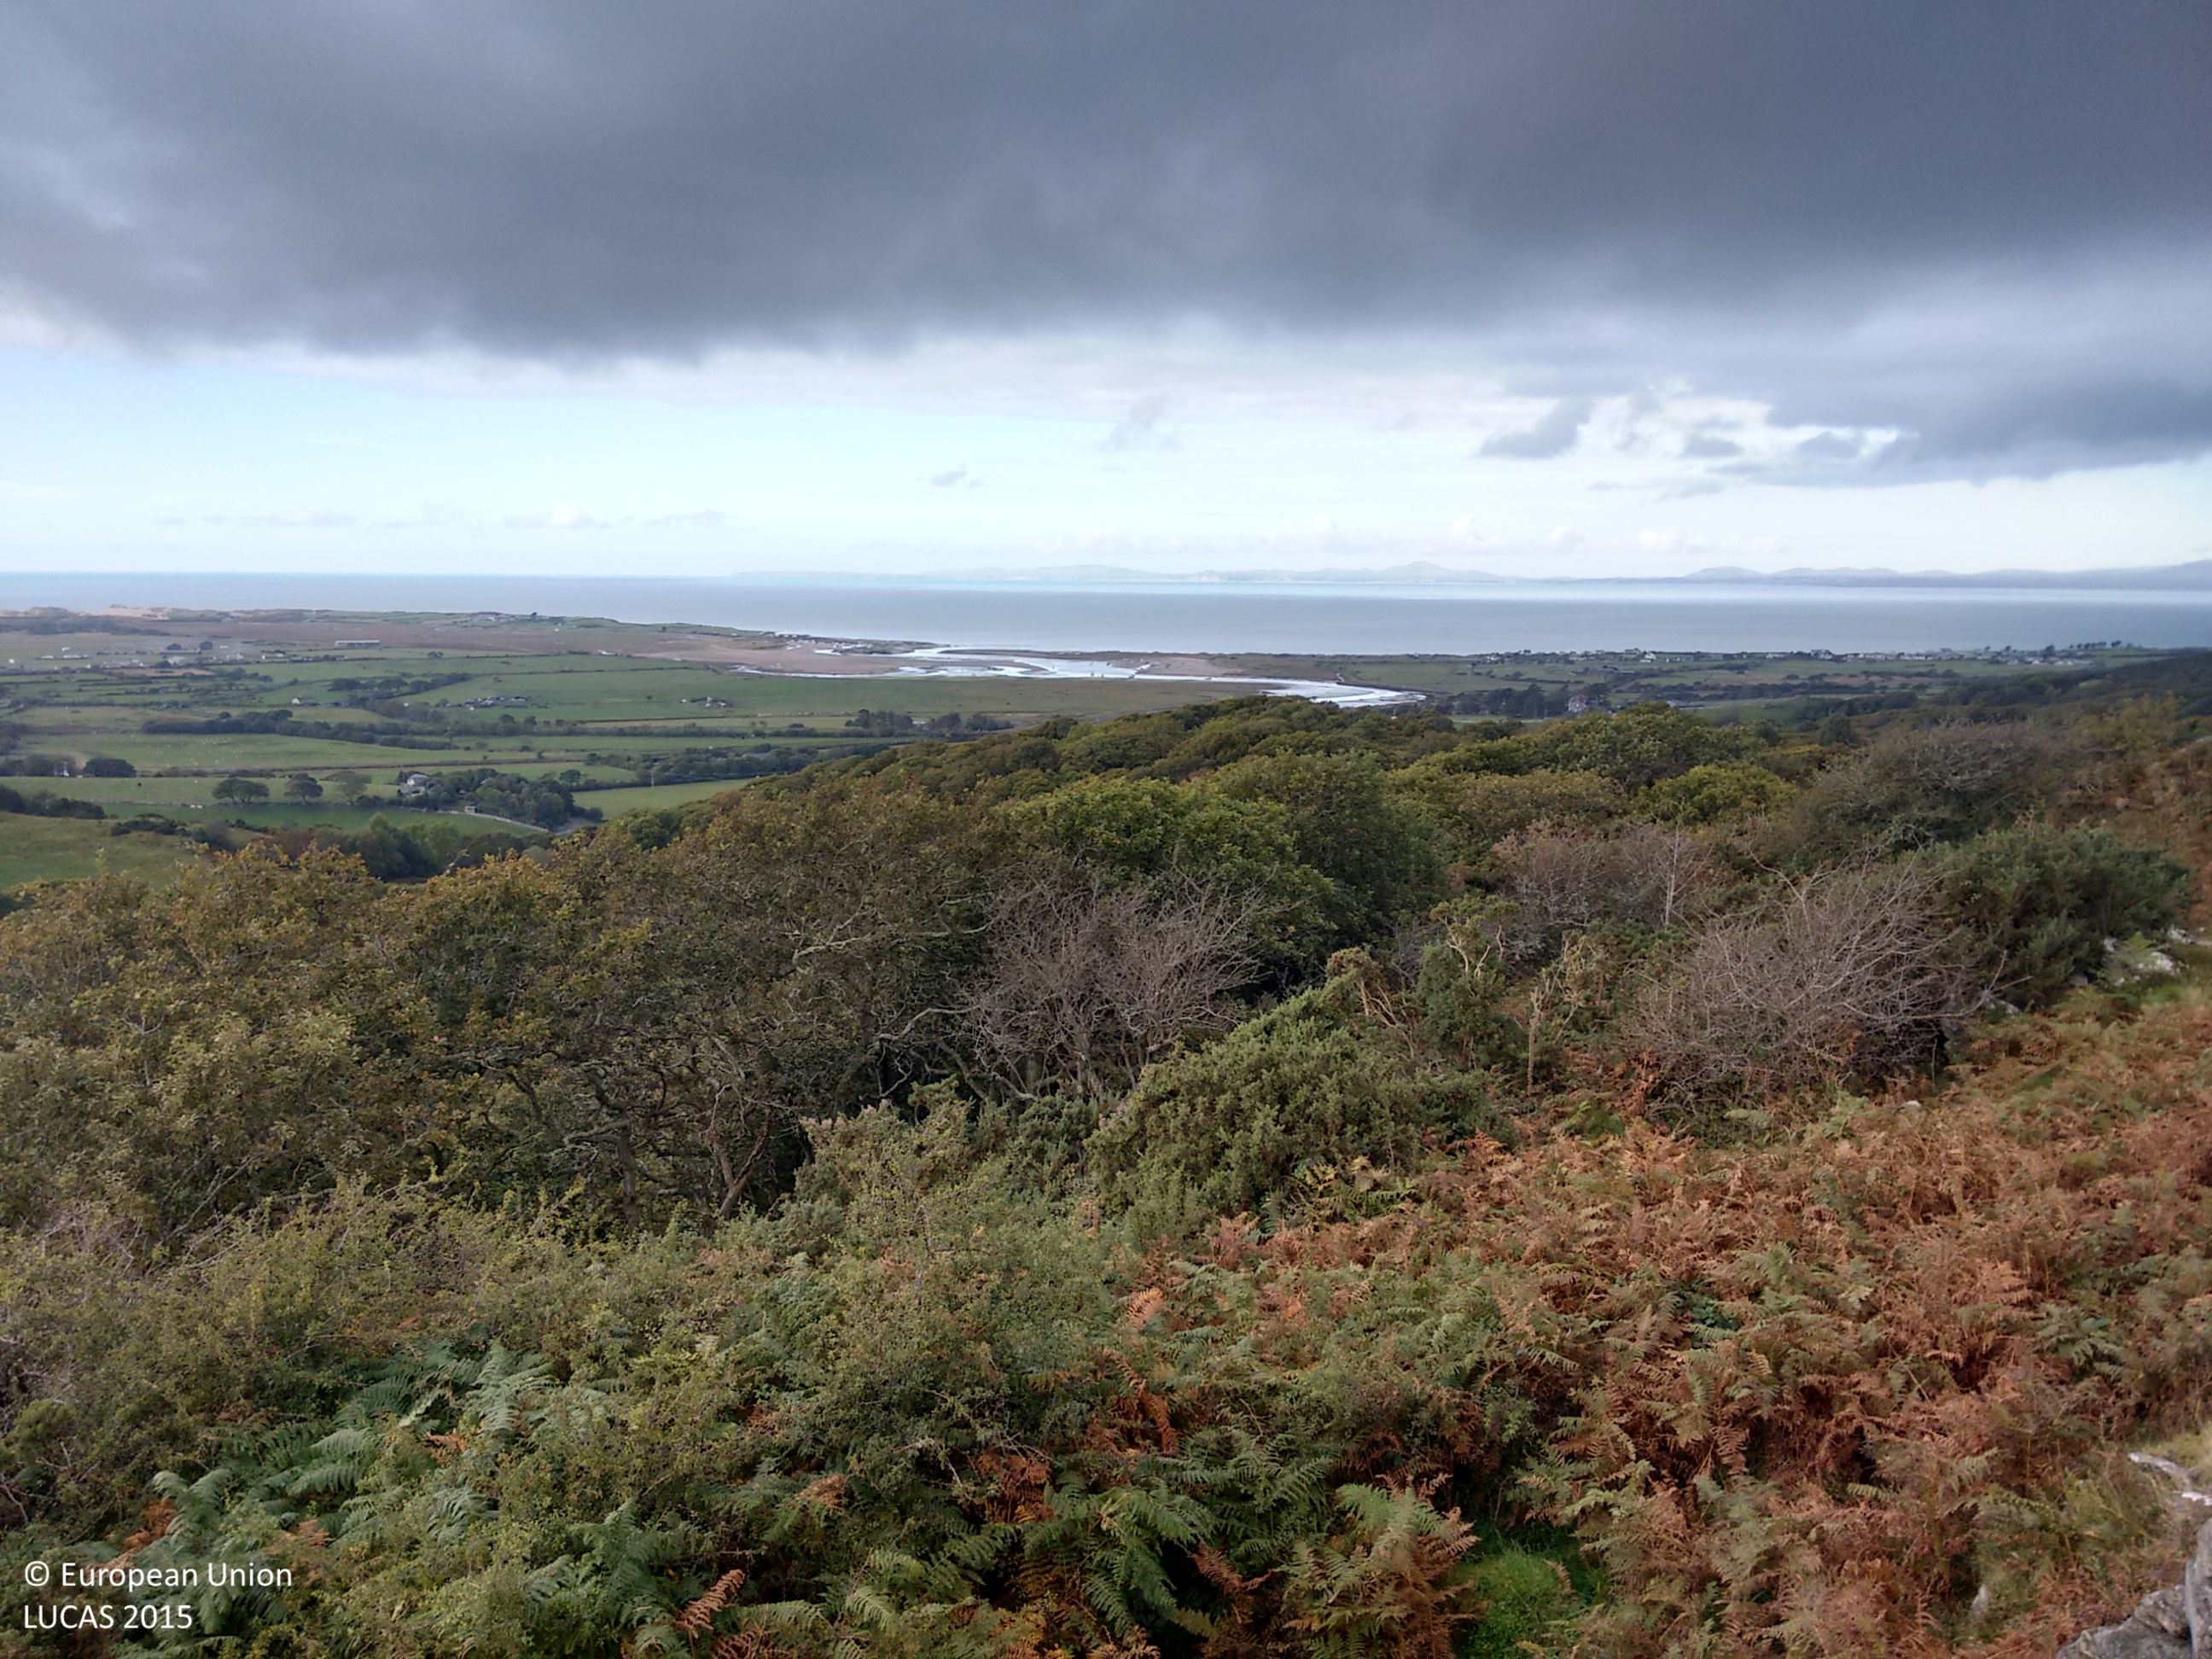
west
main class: Woodland
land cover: Broadleaved woodland
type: mesophytic deciduous forest
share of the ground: > 75 %
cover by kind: broadleaved forest trees 100 %
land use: Semi-natural and natural areas not in use
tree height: > 5 m
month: October
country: GB
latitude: 52.8279
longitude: -4.0919
